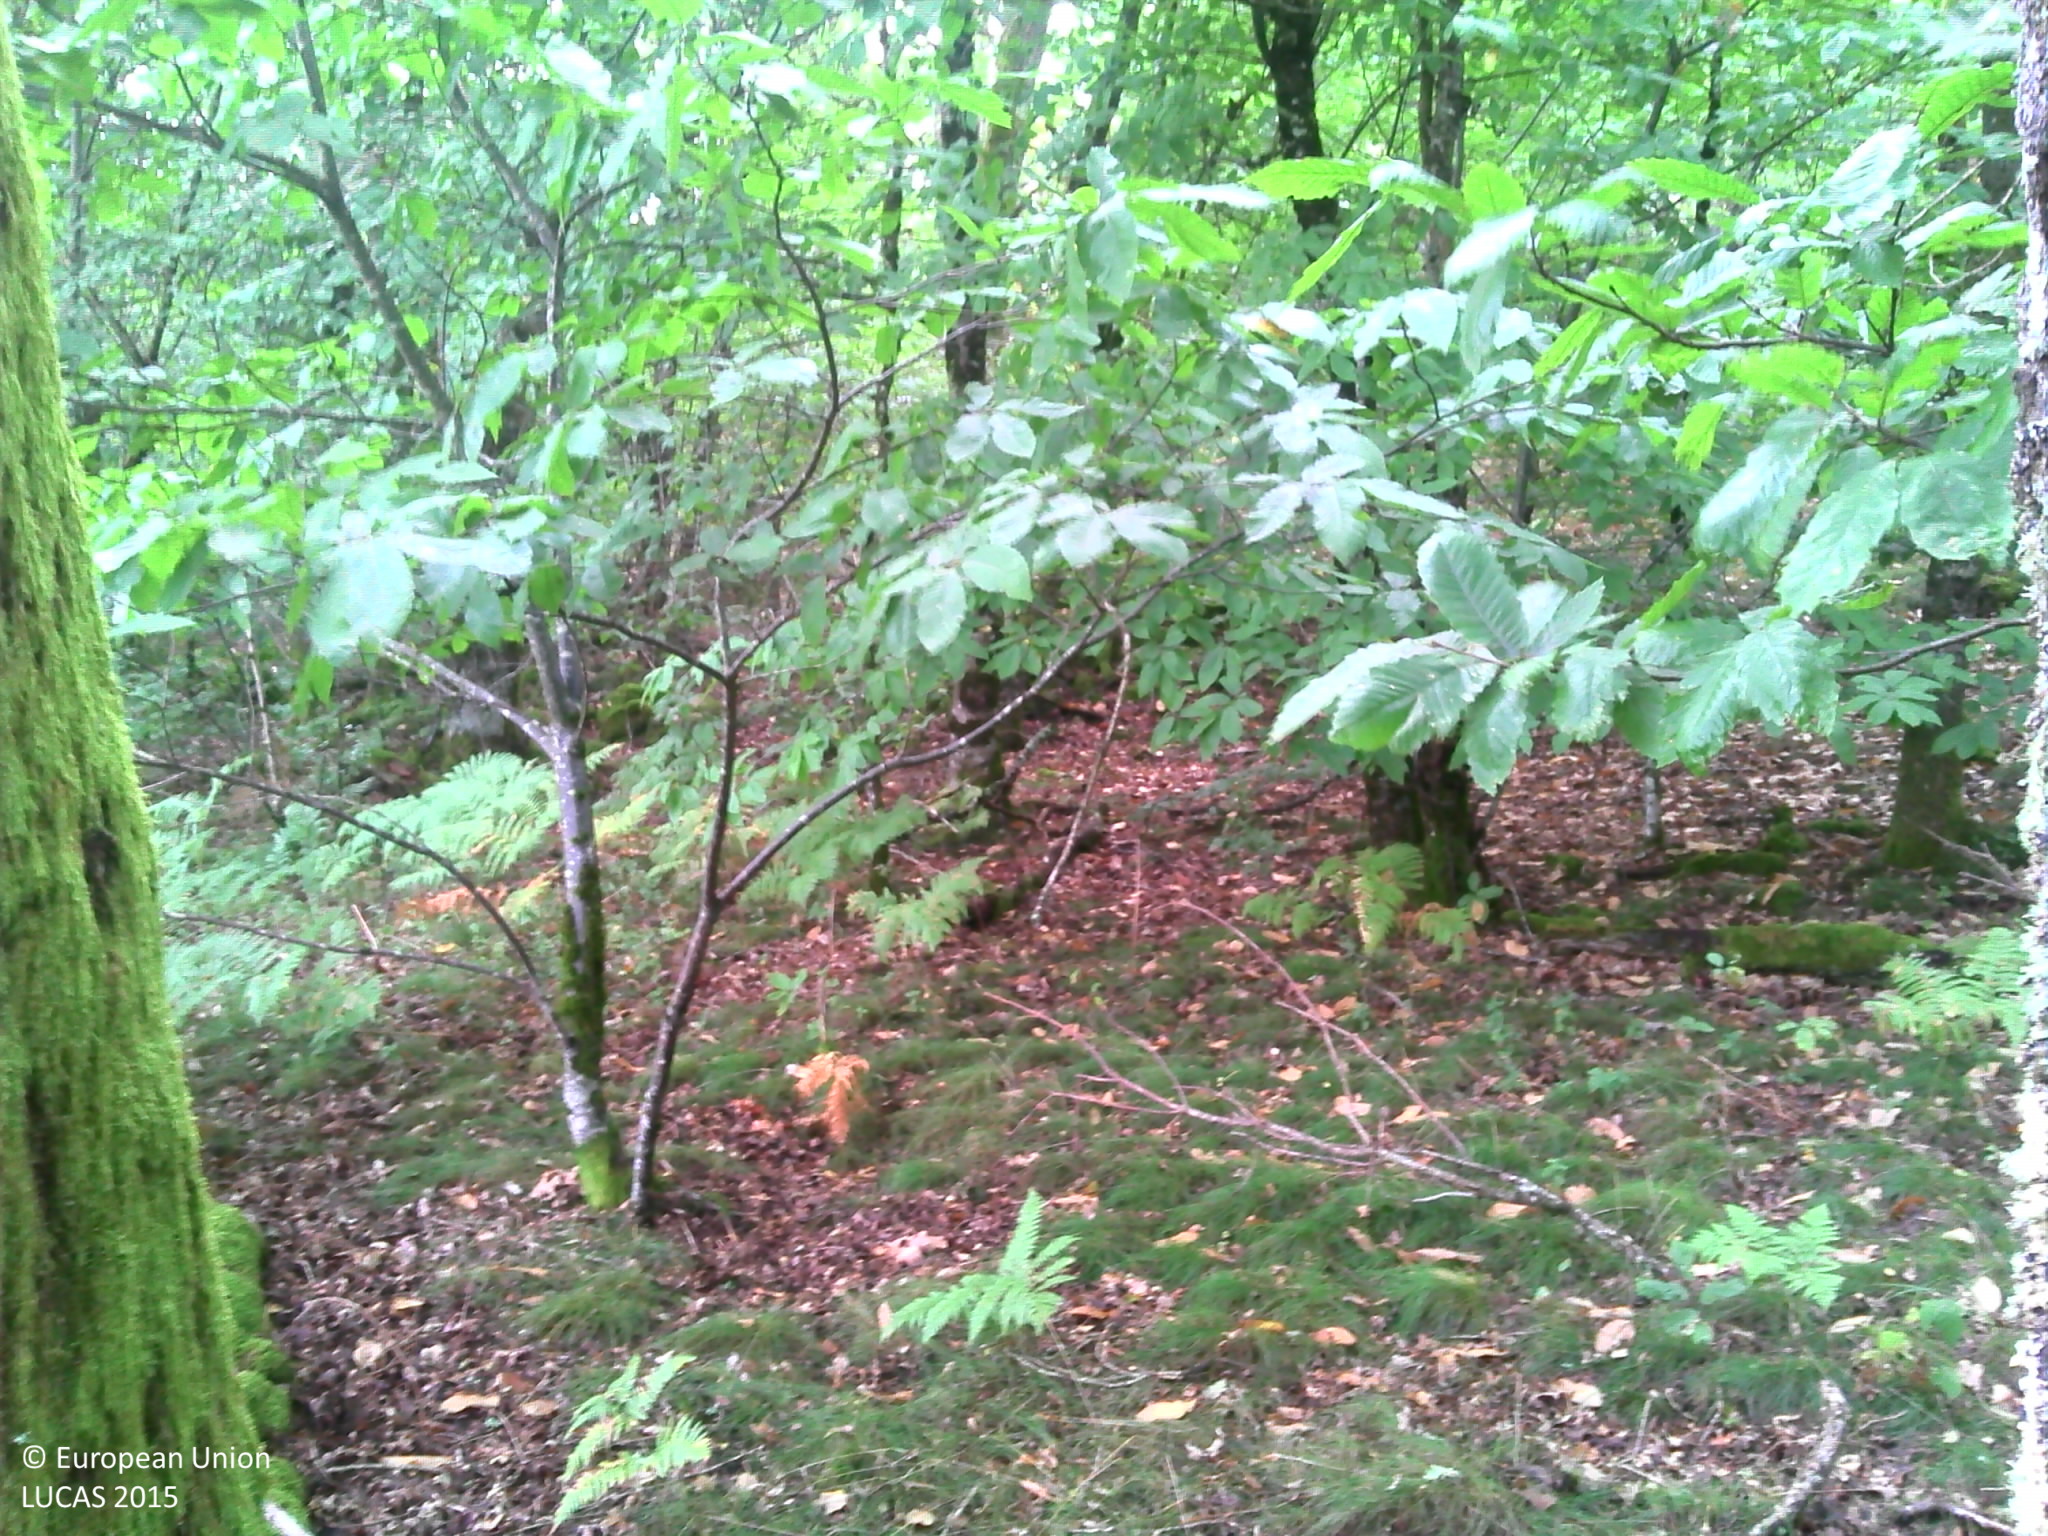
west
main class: Woodland
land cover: Broadleaved woodland
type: thermophilous deciduous forest
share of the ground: > 75 %
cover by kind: broadleaved forest trees 60 %, herbaceous plants 40 %
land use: Forestry
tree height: > 5 m
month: August
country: FR
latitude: 45.4406
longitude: 1.8265
